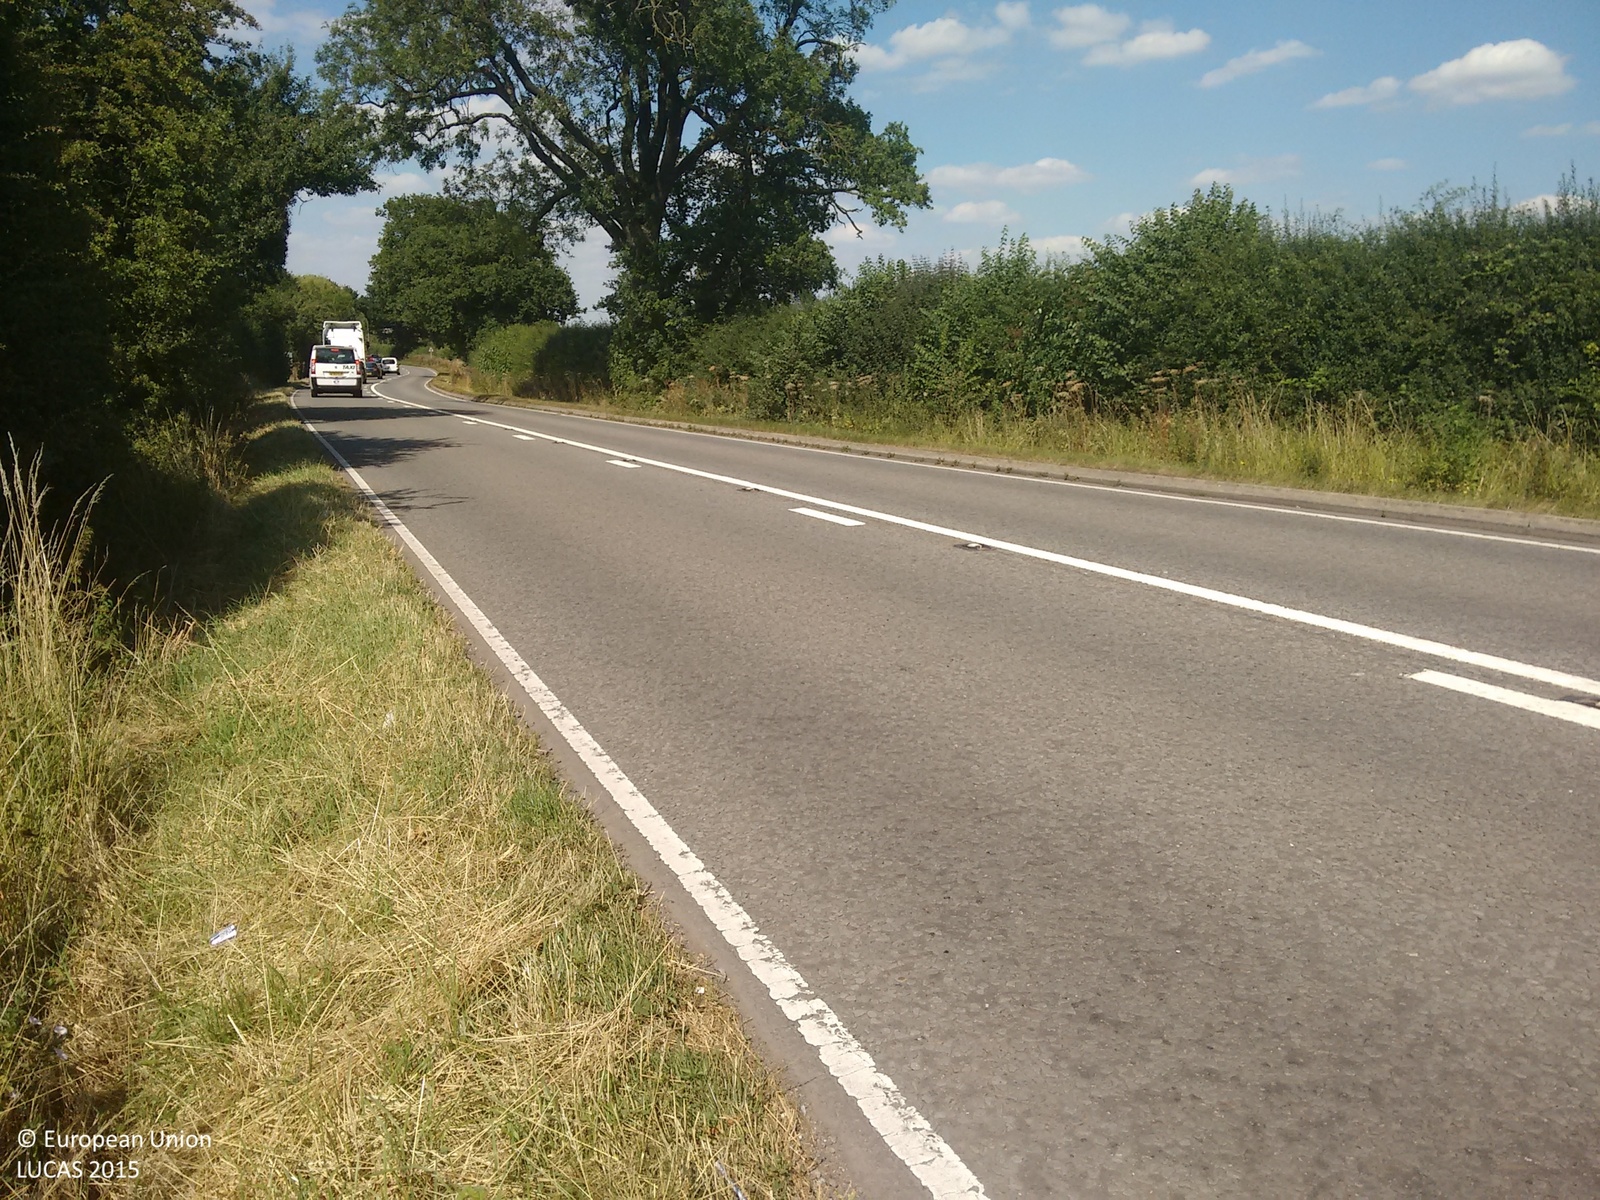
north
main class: Cropland
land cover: Common wheat
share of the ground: > 75 %
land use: Agriculture (excluding fallow land and kitchen gardens)
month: August
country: GB
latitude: 52.5629
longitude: -1.4834
